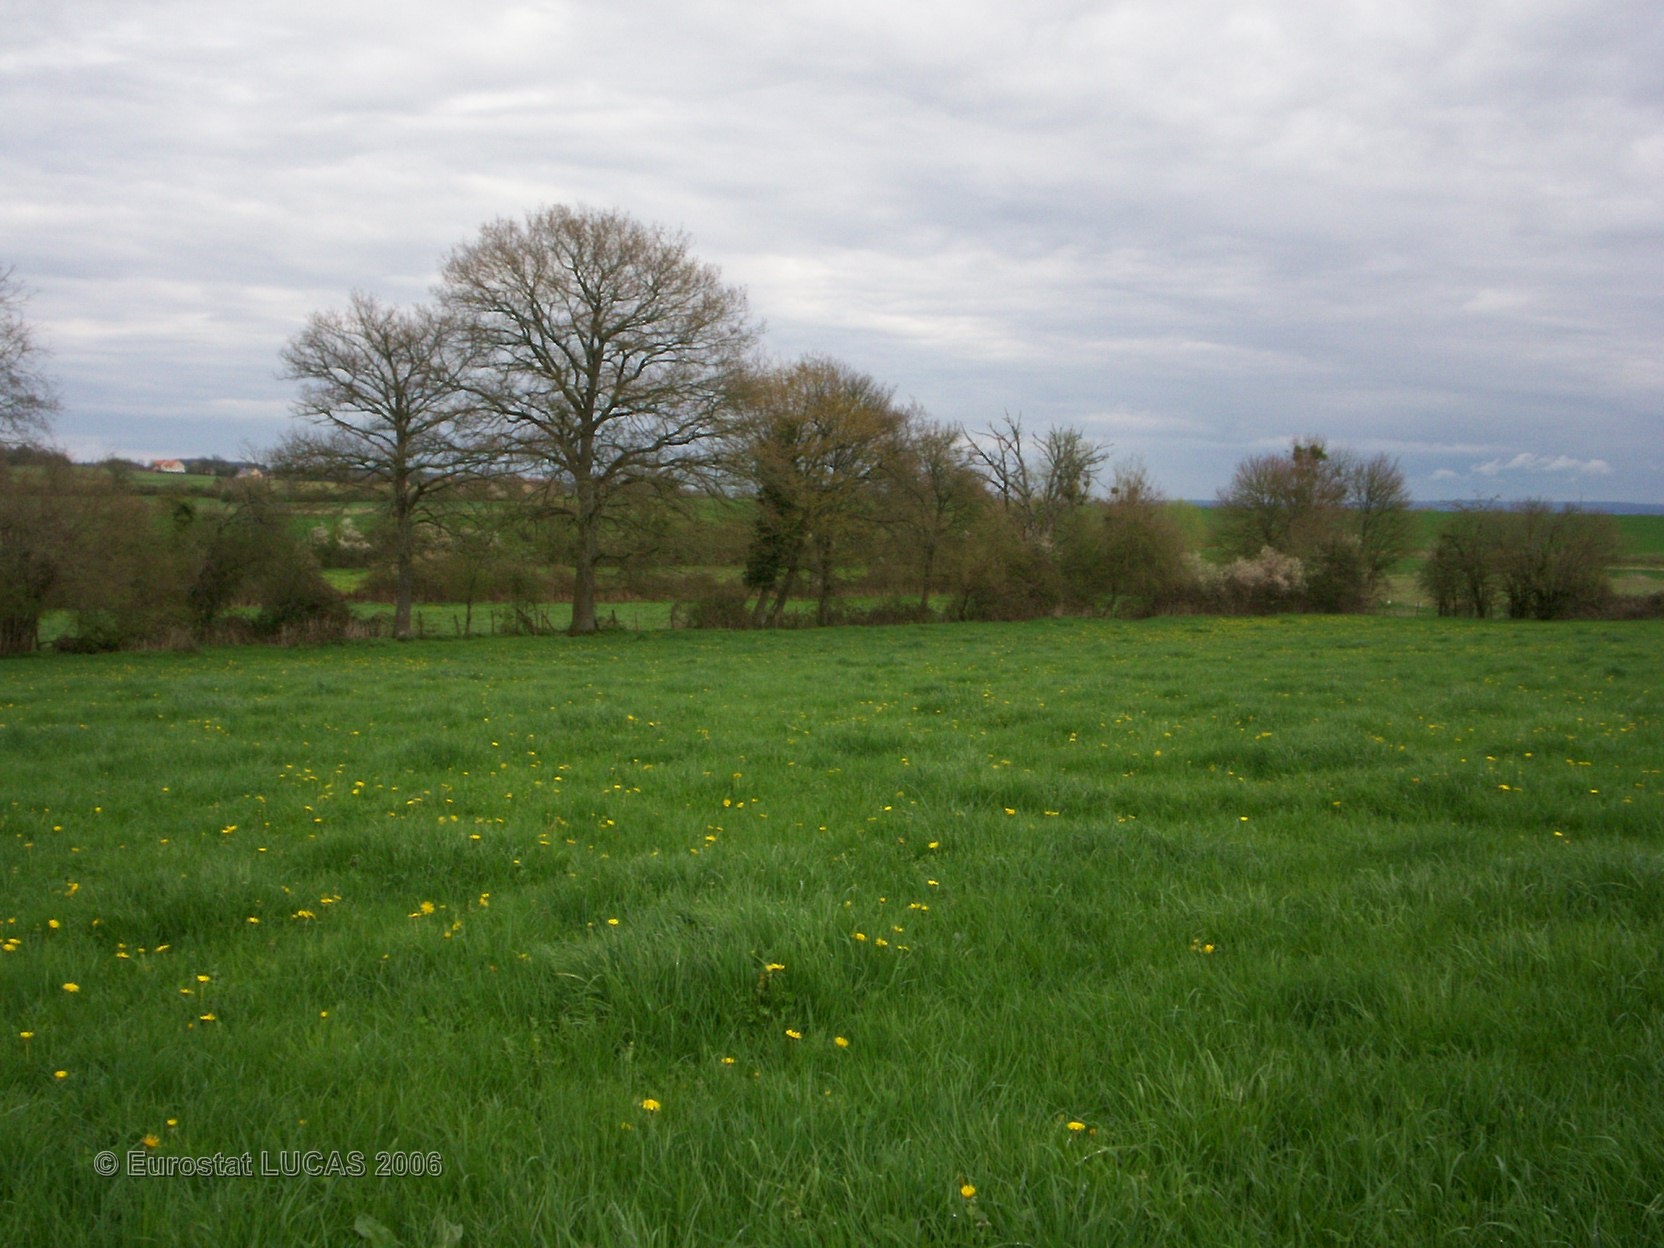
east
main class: Grassland
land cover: Grassland without tree/shrub cover
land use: Agriculture (excluding fallow land and kitchen gardens)
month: April
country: FR
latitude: 47.4447
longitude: 3.0590
